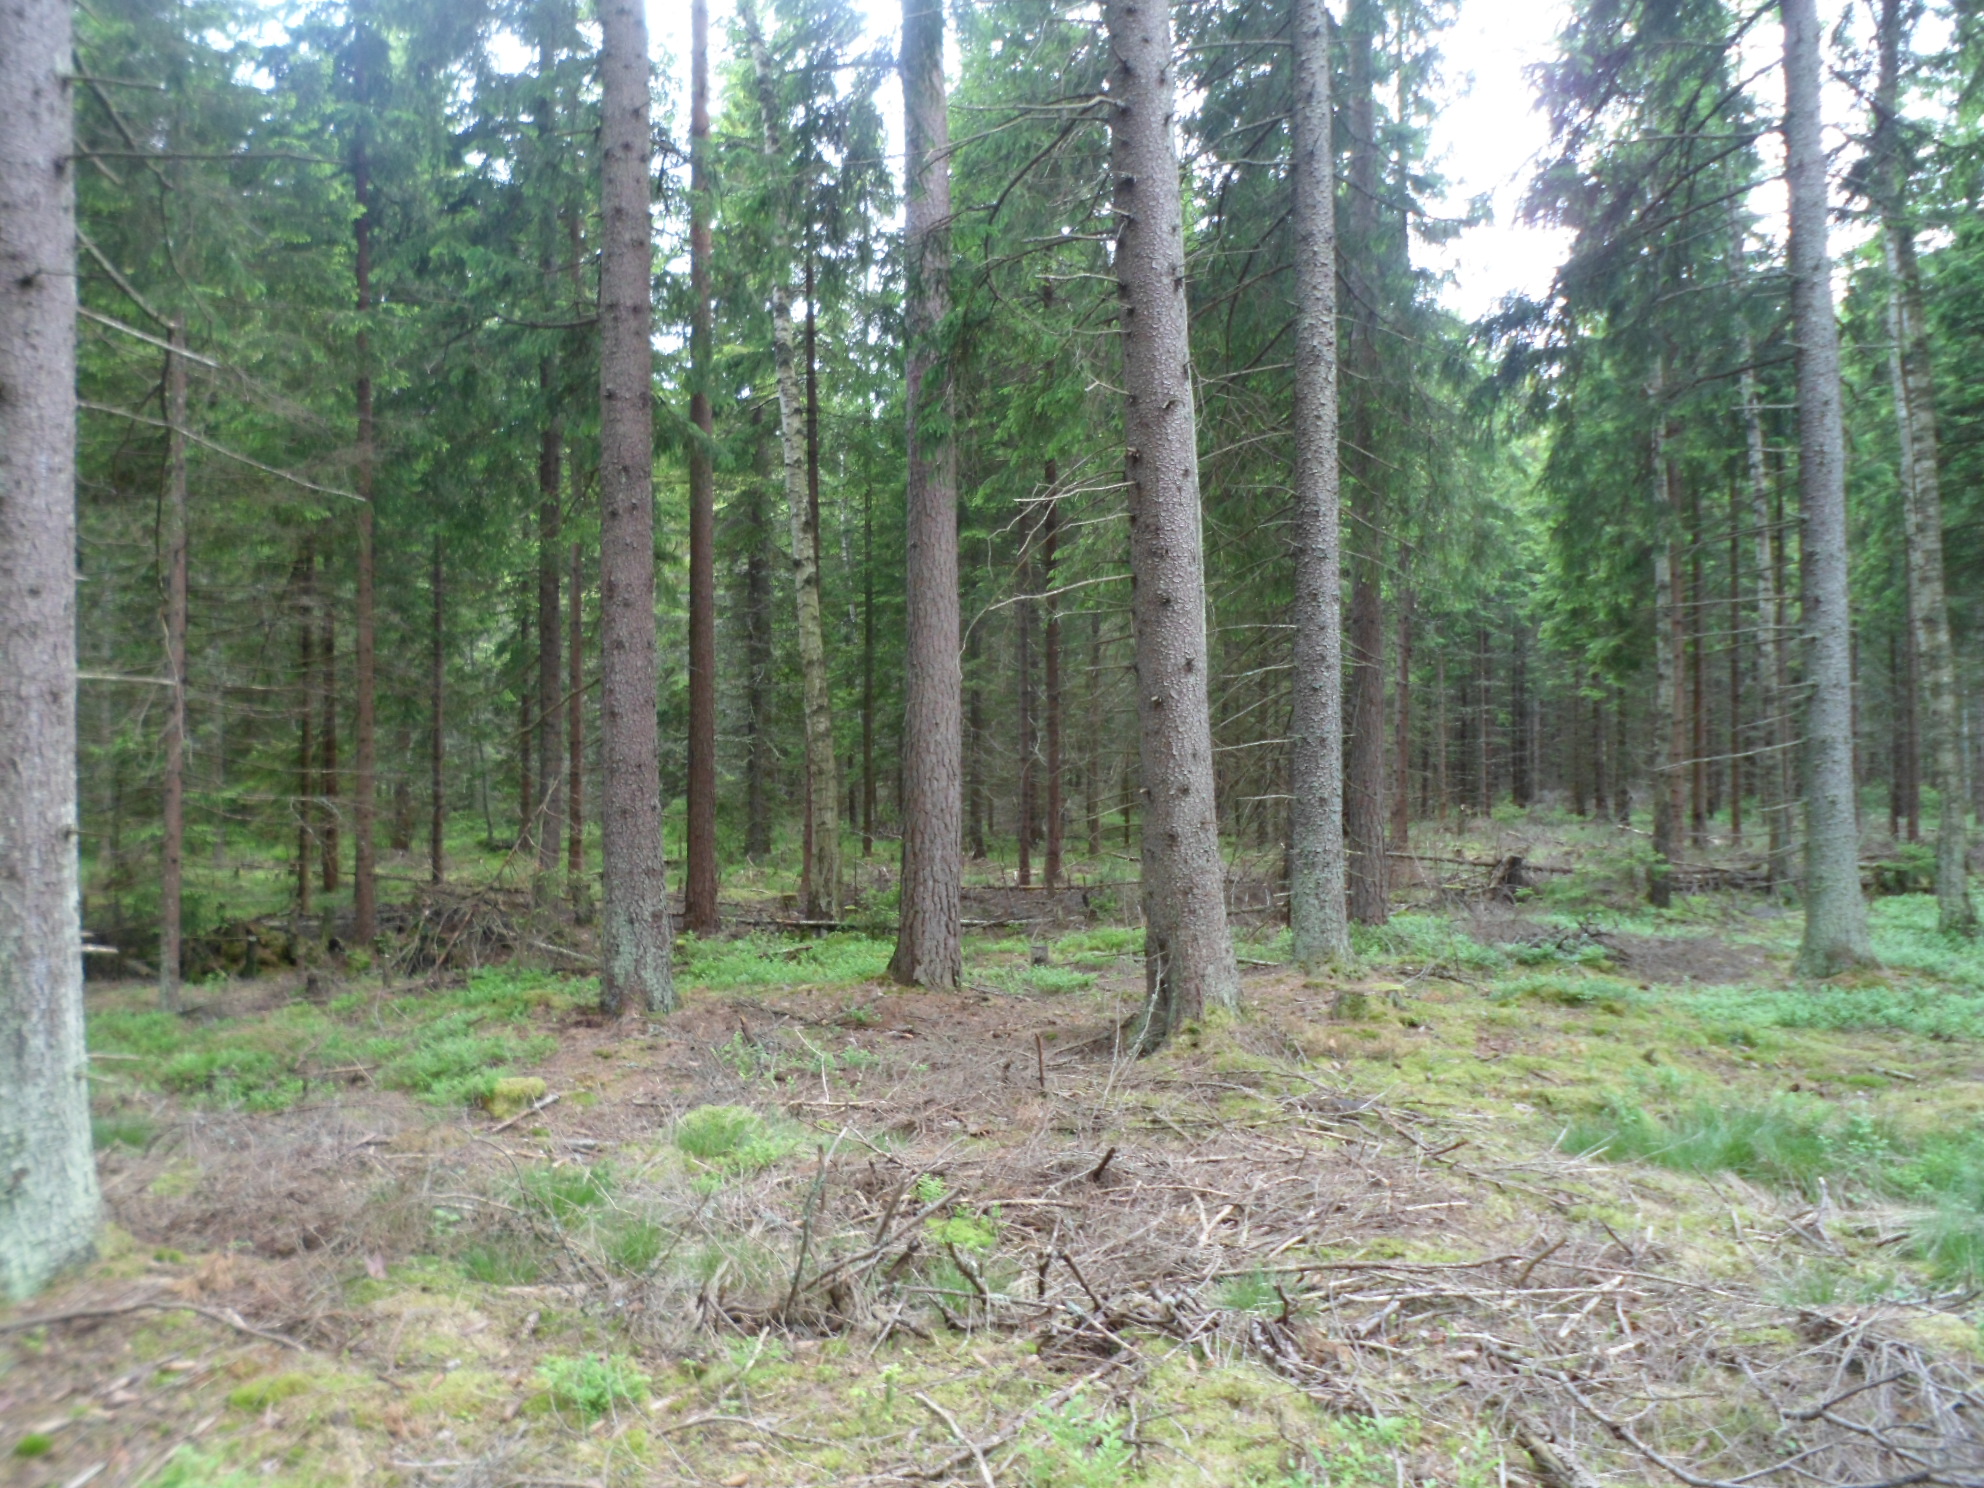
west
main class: Woodland
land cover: Spruce dominated coniferous woodland
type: boreal forest
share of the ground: 50 - 75 %
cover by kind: coniferous forest trees 55 %, lichens and mosses 20 %, shrubs 15 %, herbaceous plants 5 %, unconsolidated bare surface 5 %
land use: Forestry
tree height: > 5 m
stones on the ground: < 10 %
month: June
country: SE
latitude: 57.1083
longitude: 15.2311
